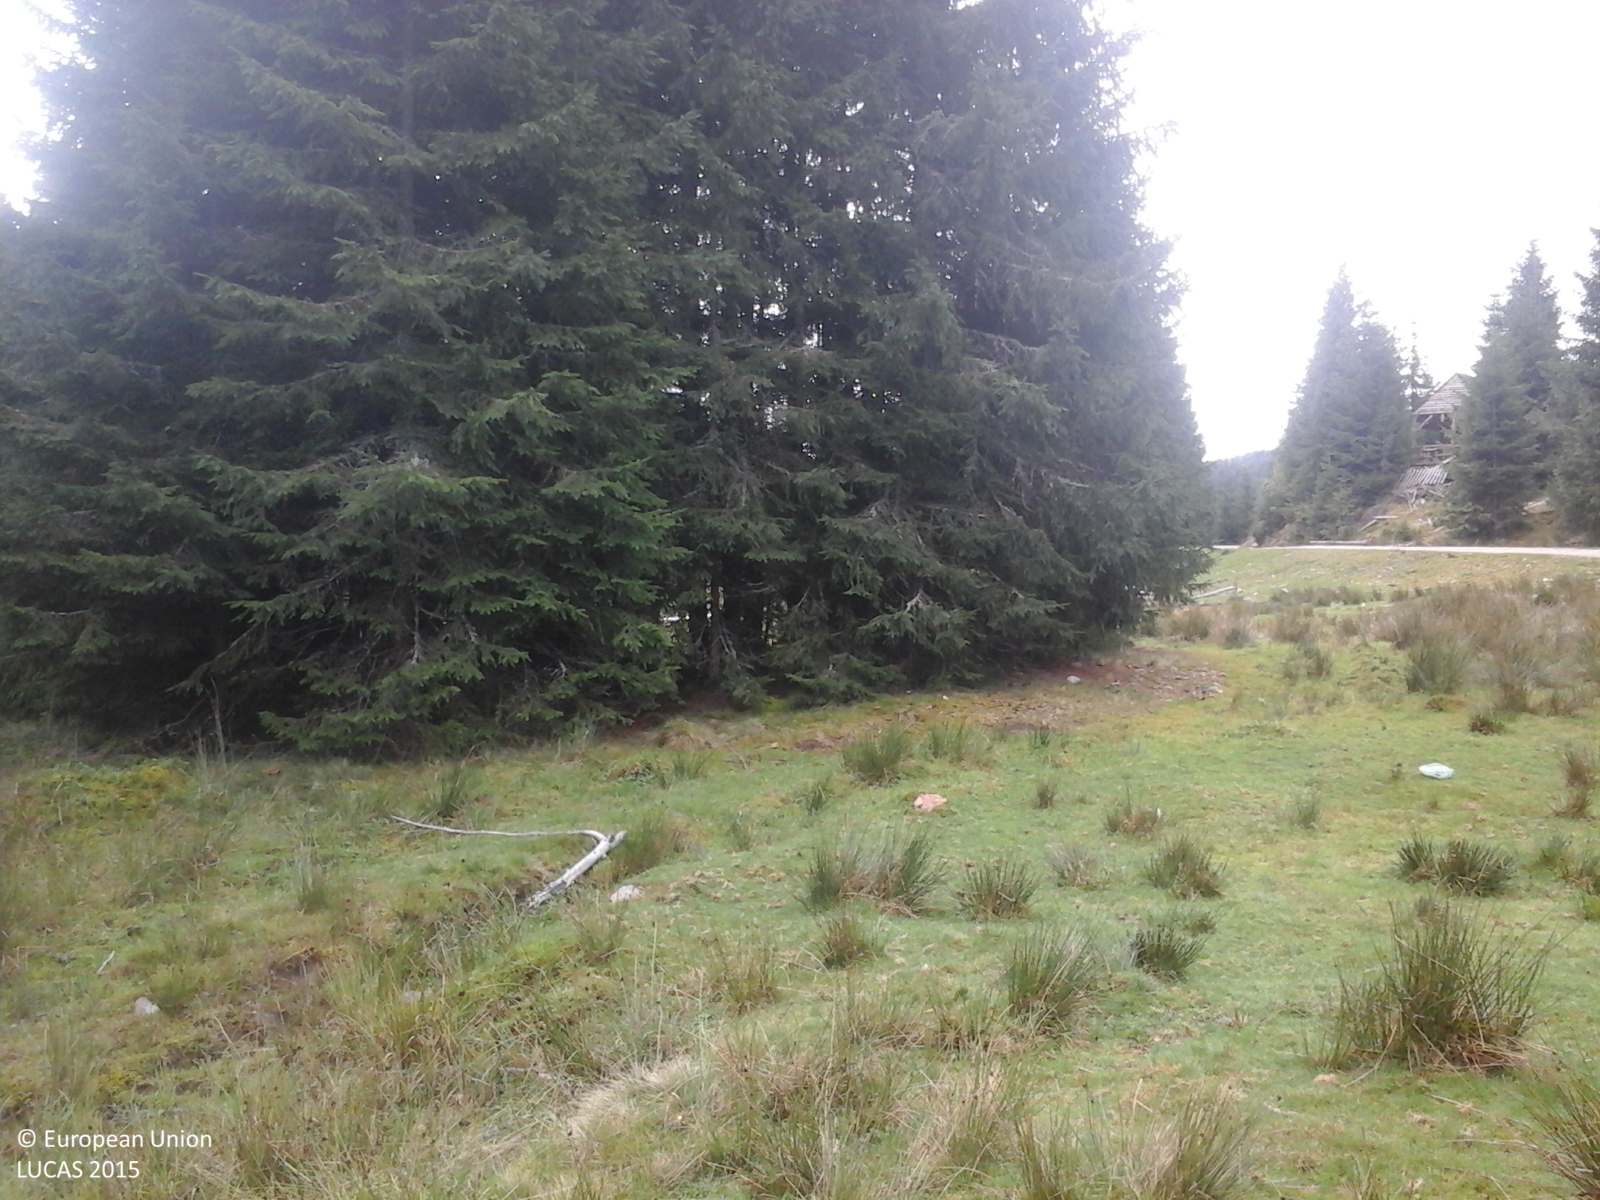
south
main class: Woodland
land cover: Spruce dominated coniferous woodland
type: alpine coniferous forest
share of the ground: > 75 %
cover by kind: coniferous forest trees 100 %
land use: Forestry
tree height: > 5 m
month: September
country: RO
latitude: 46.5698
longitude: 23.0421
